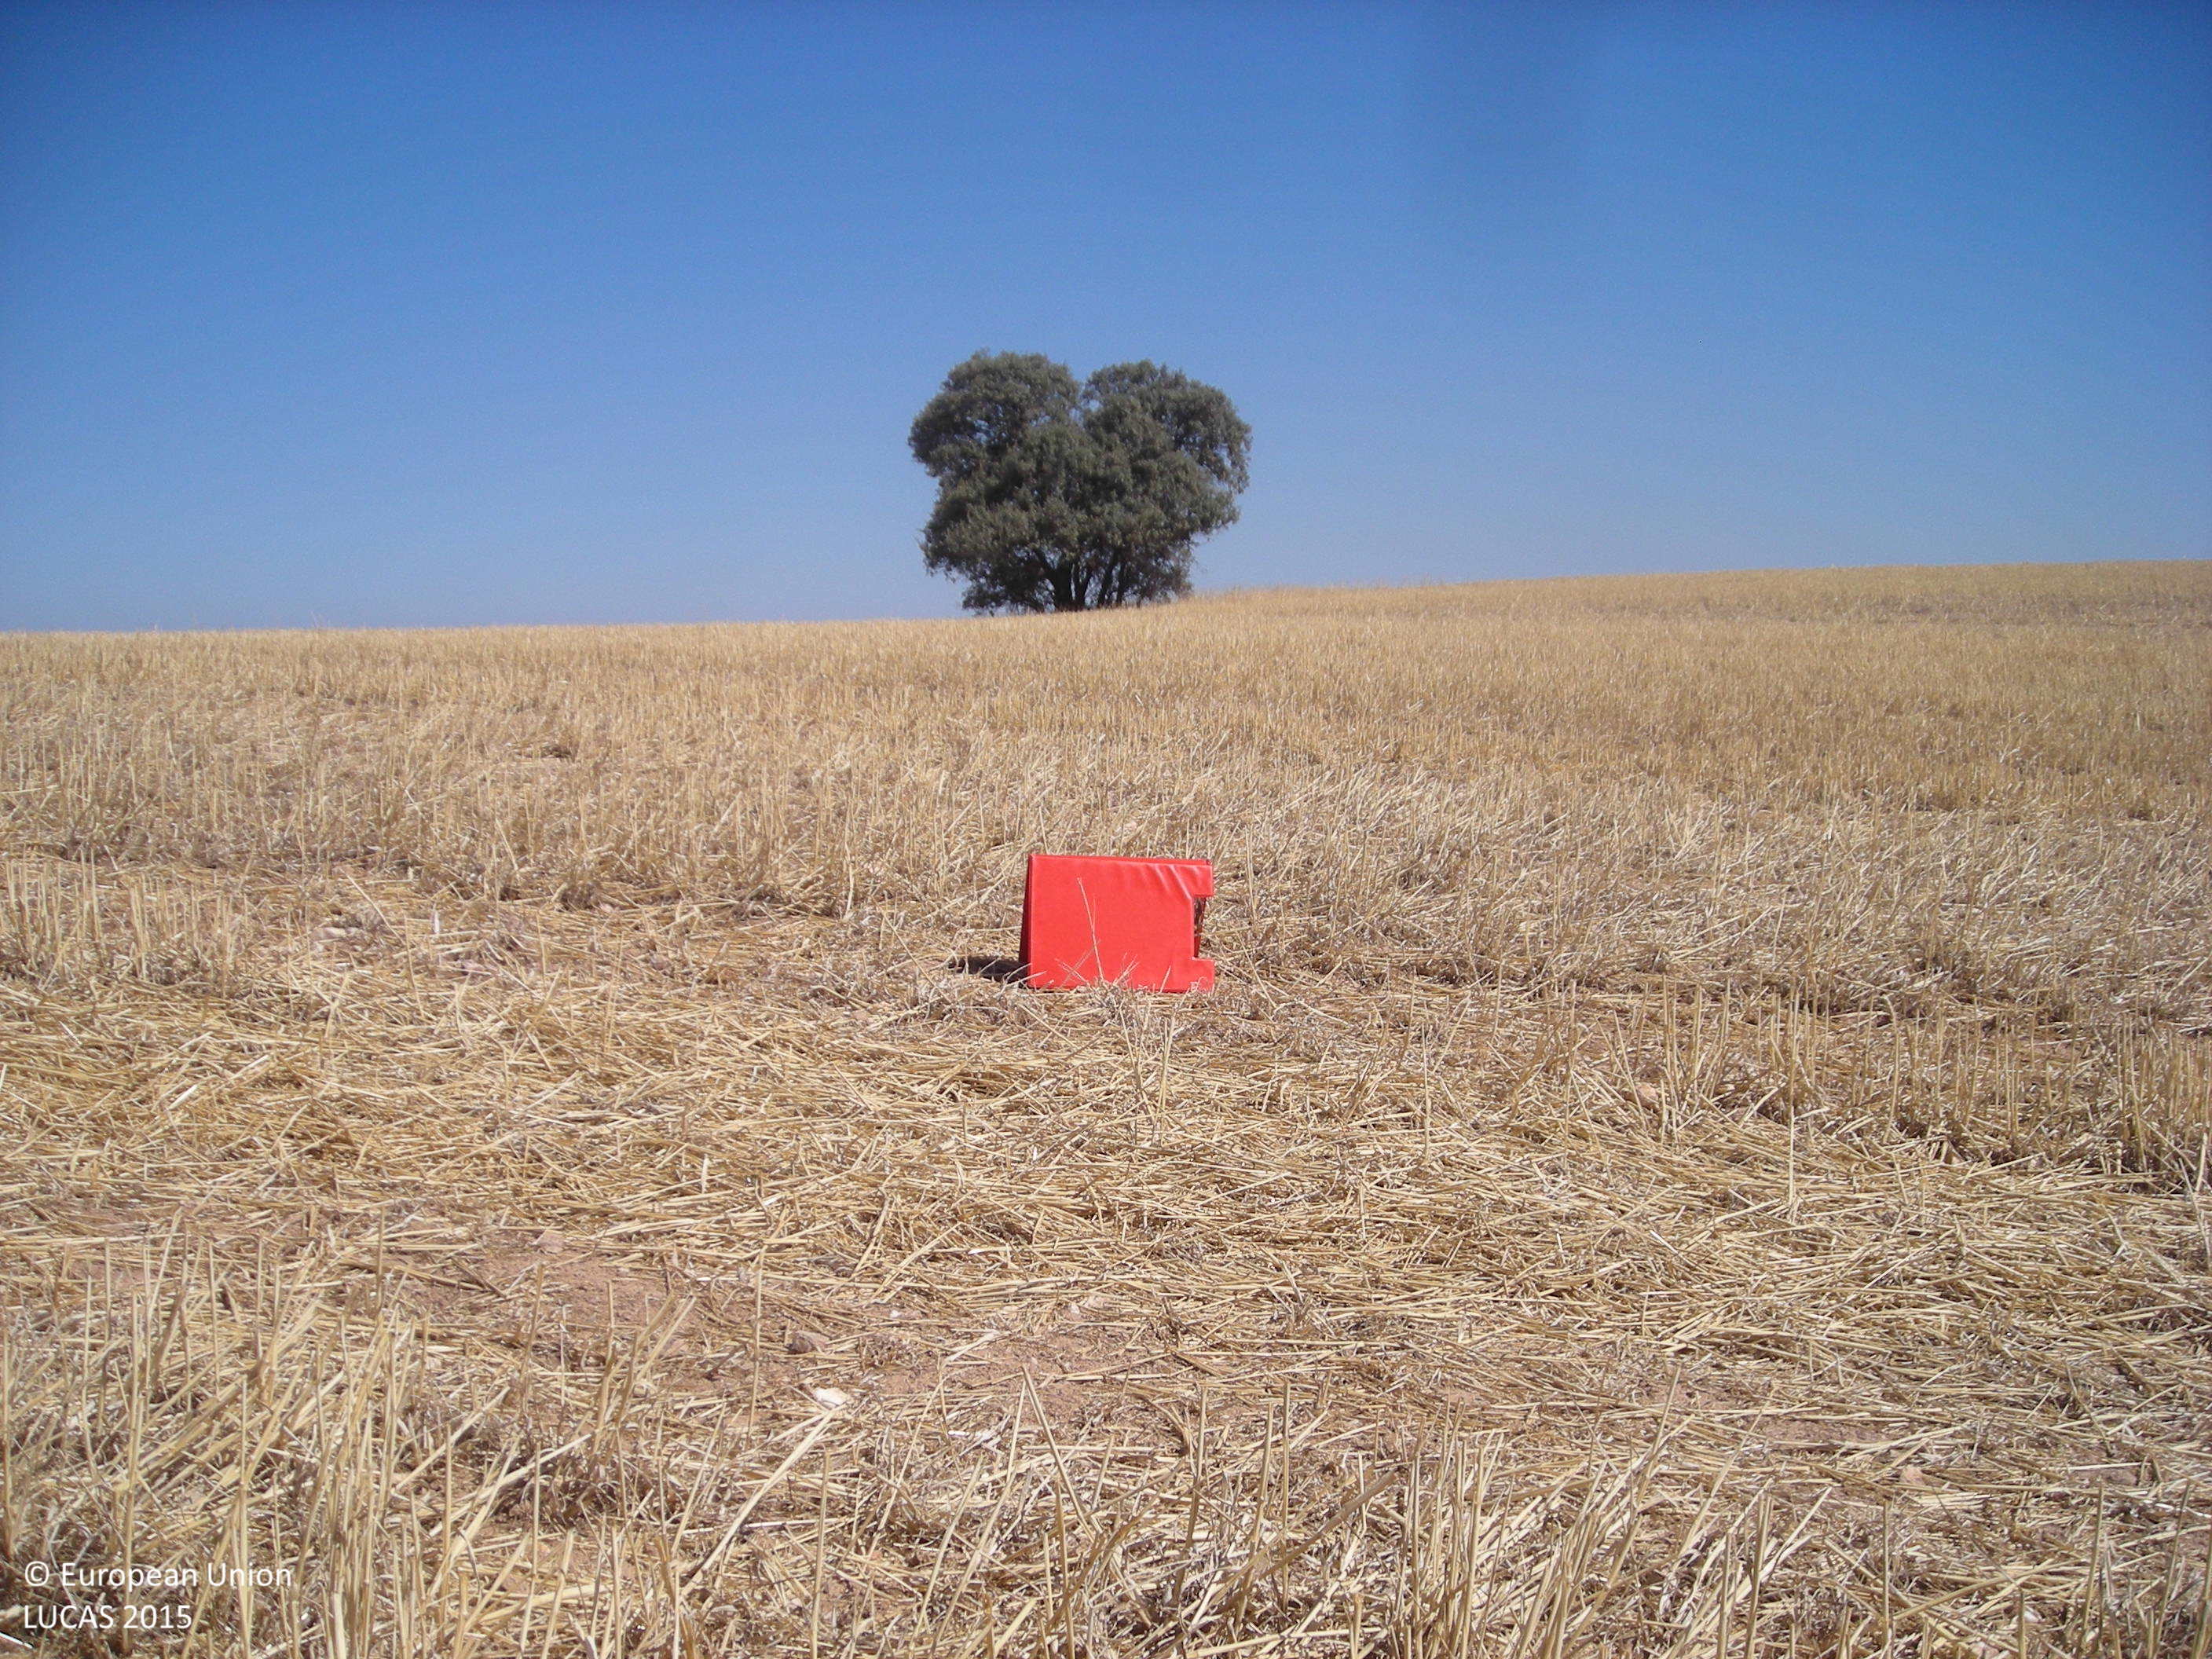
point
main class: Cropland
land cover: Common wheat
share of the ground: > 75 %
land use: Agriculture (excluding fallow land and kitchen gardens)
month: July
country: ES
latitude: 38.8308
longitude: -5.9102
